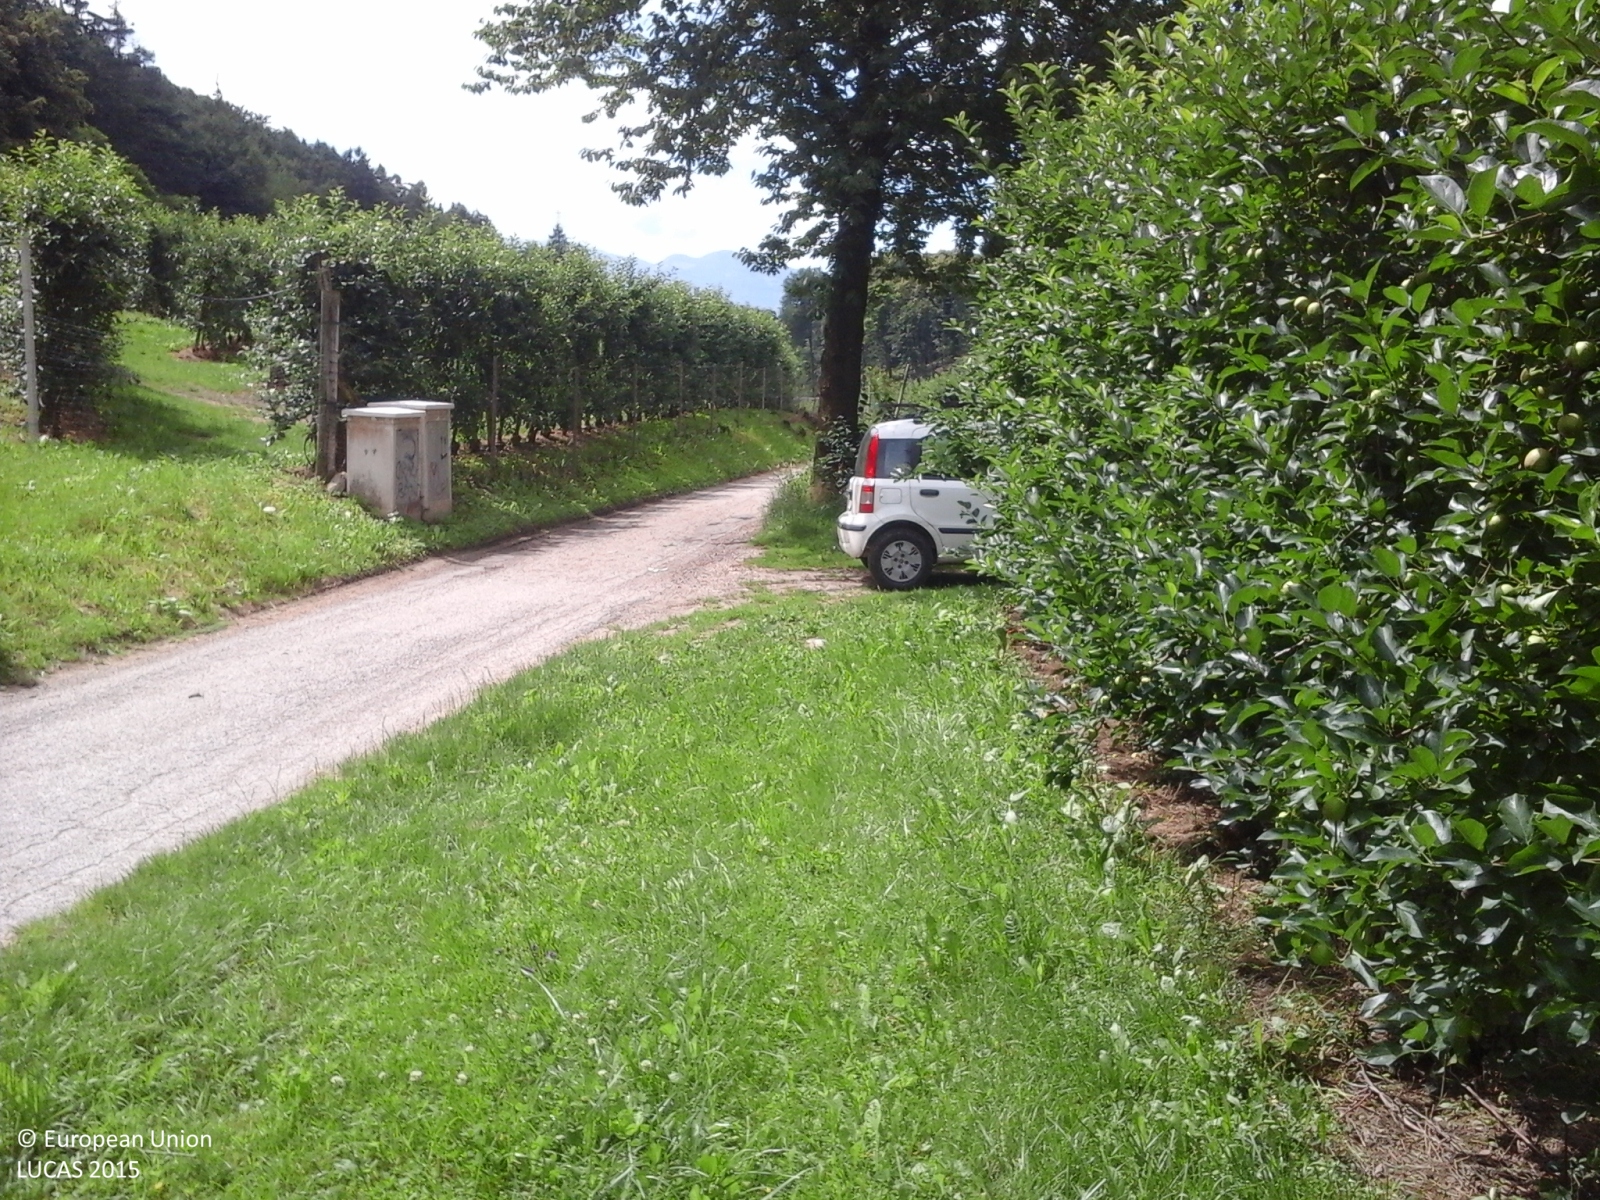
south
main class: Cropland
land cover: Apple fruit
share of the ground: 25 - 50 %
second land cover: Grassland without tree/shrub cover
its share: > 75 %
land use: Agriculture (excluding fallow land and kitchen gardens)
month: May
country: IT
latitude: 46.4338
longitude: 11.2608
